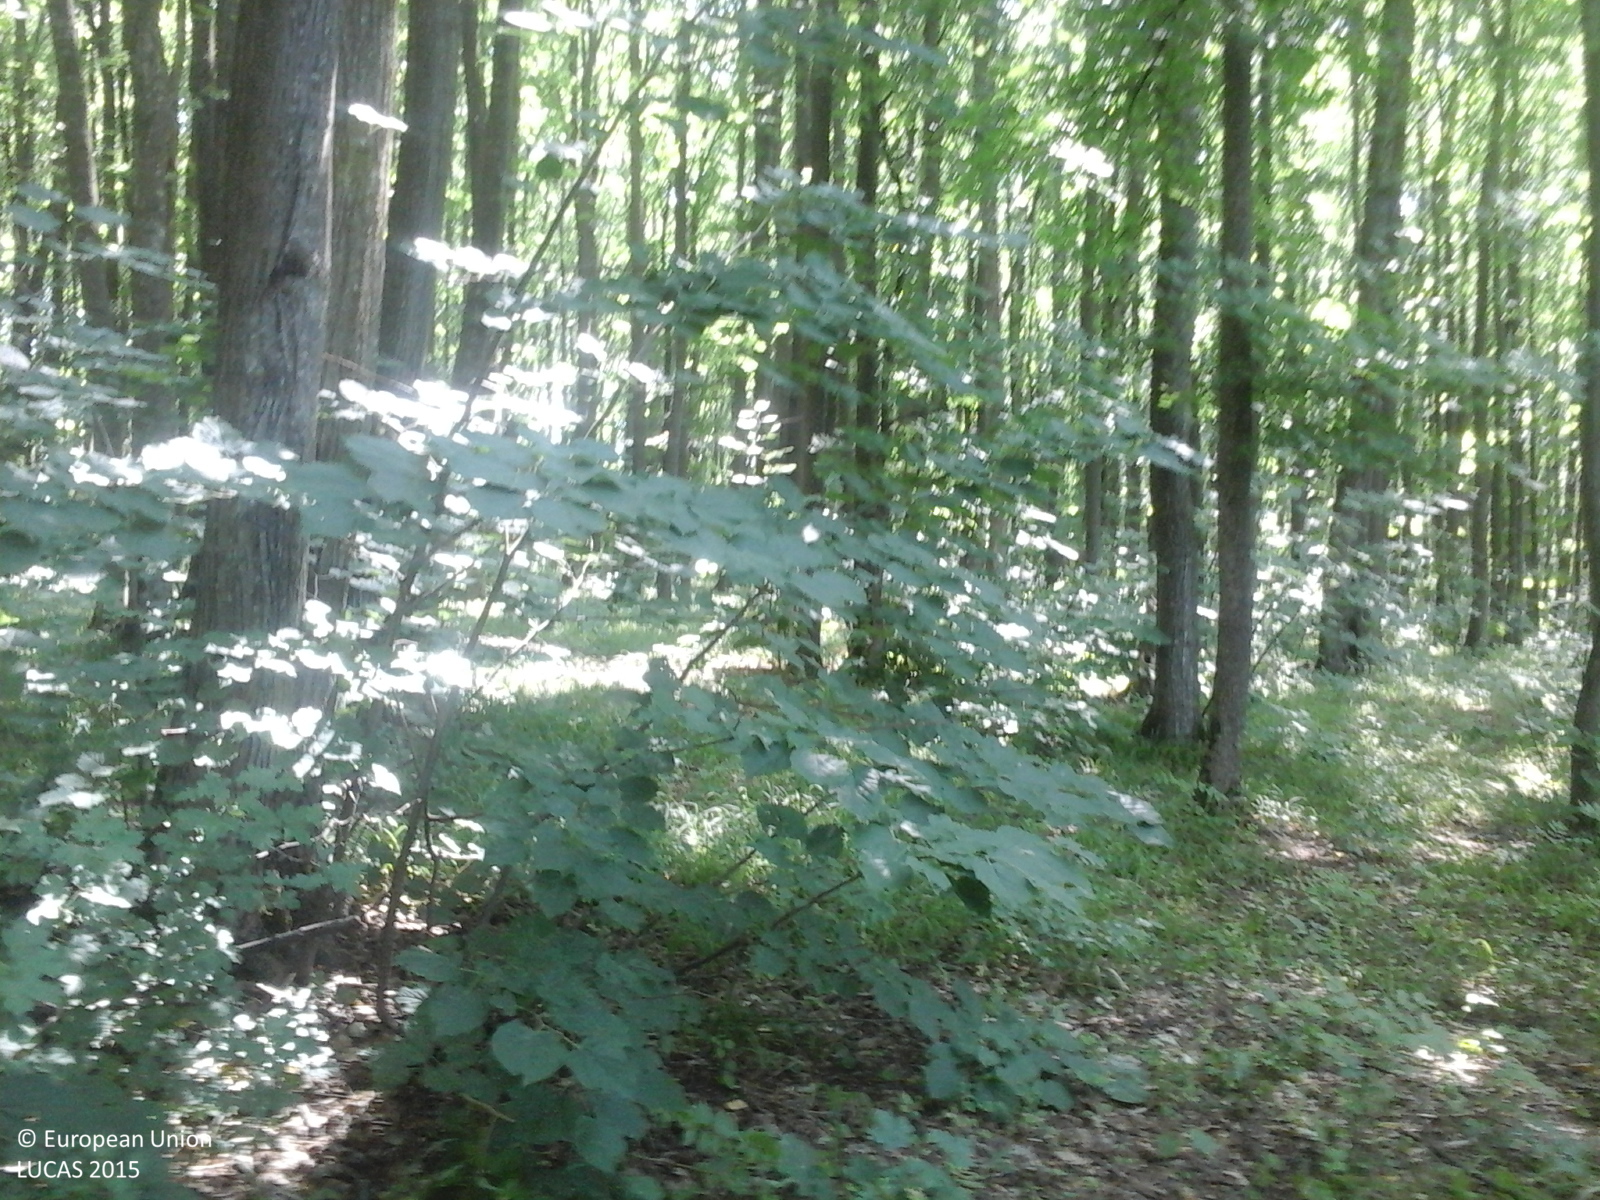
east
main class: Woodland
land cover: Broadleaved woodland
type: beech forest
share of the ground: > 75 %
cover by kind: broadleaved forest trees 95 %, herbaceous plants 5 %
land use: Forestry
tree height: > 5 m
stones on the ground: < 10 %
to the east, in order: Broadleaved woodland
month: June
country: RO
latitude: 46.9376
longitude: 27.2759
